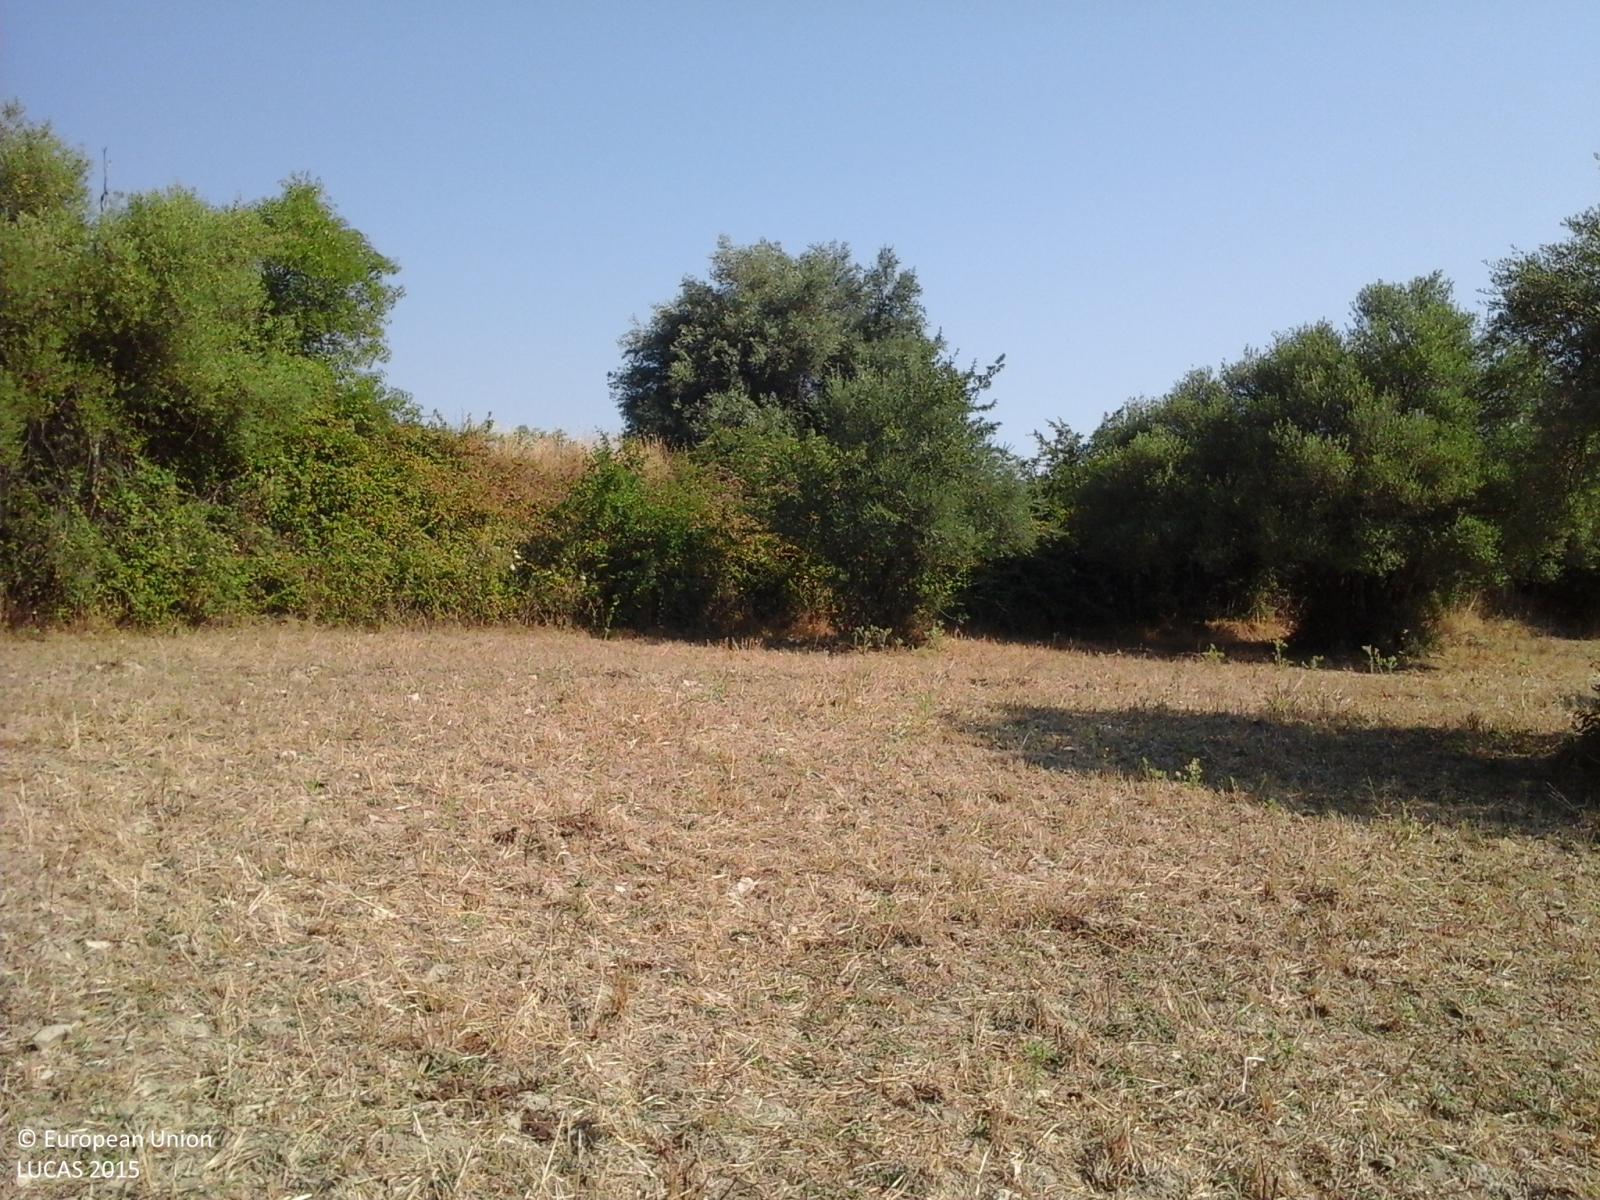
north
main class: Cropland
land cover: Mixed cereals for fodder
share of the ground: > 75 %
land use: Agriculture (excluding fallow land and kitchen gardens)
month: July
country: IT
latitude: 37.0585
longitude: 14.8766
